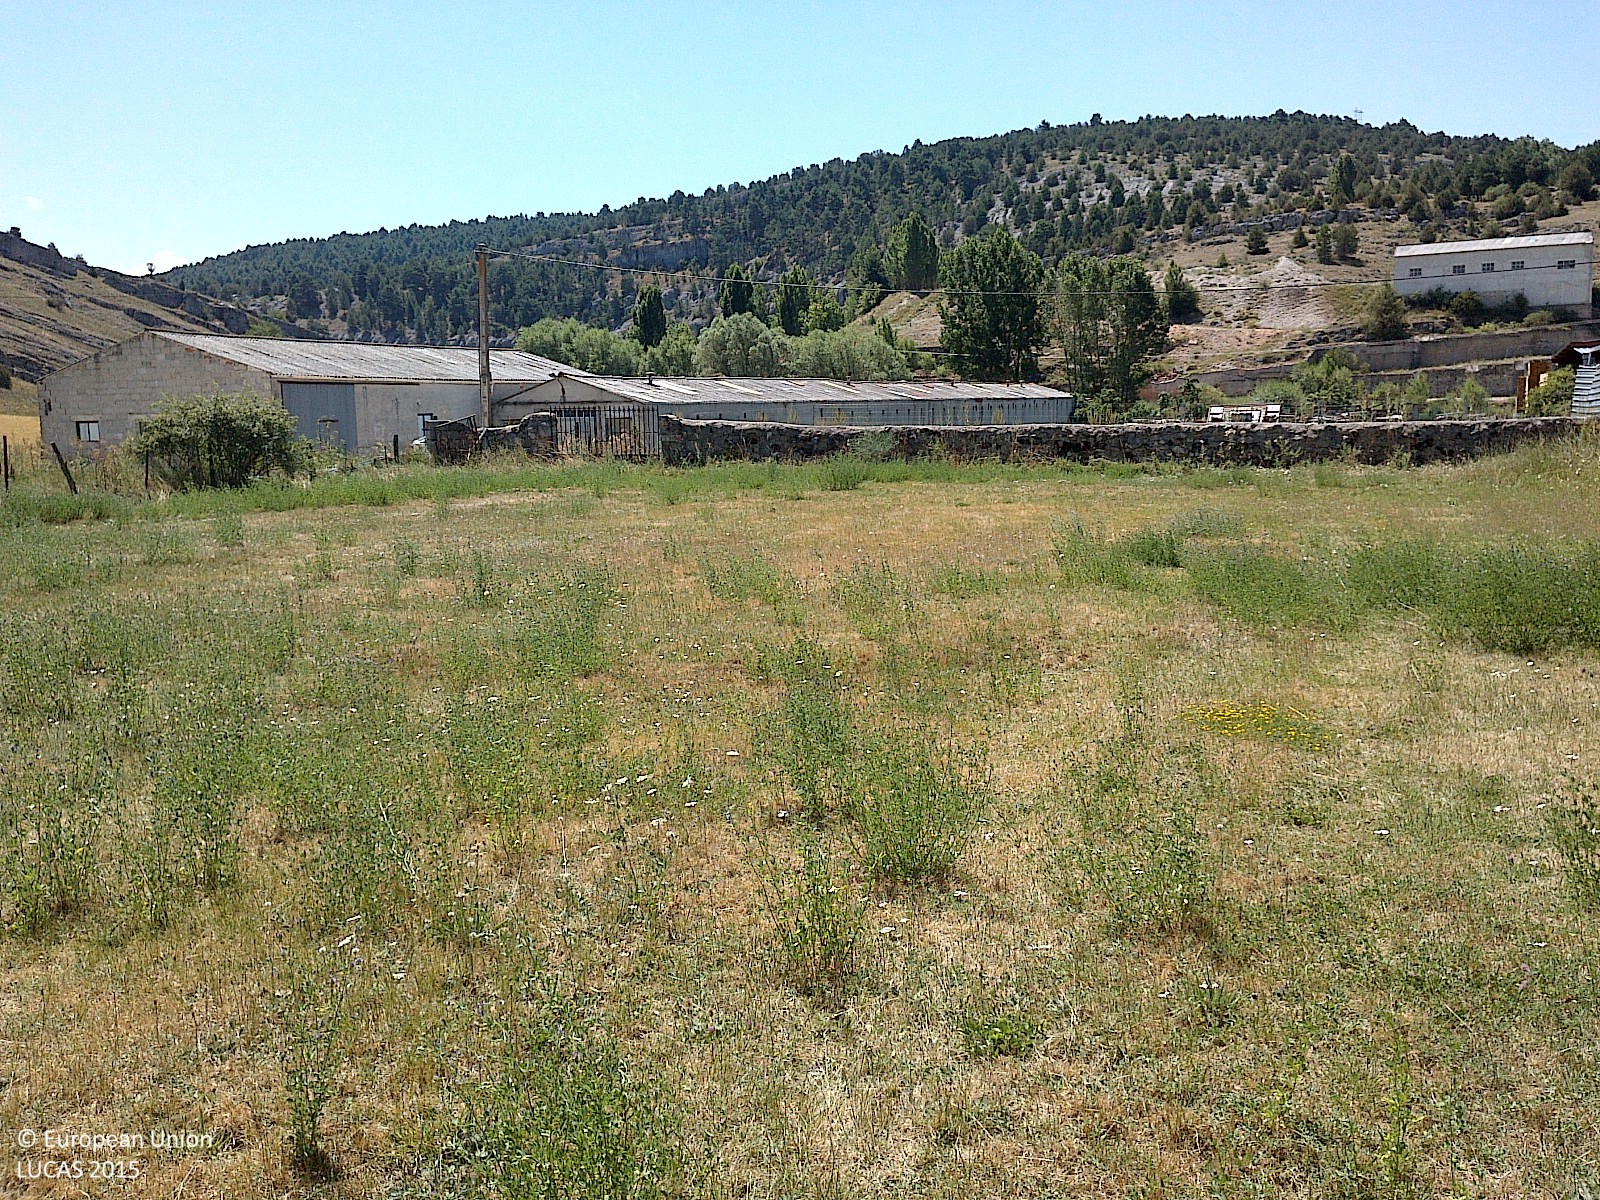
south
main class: Grassland
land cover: Grassland without tree/shrub cover
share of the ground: > 75 %
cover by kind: herbaceous plants 100 %
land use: Semi-natural and natural areas not in use
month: July
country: ES
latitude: 41.8456
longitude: -3.1631
